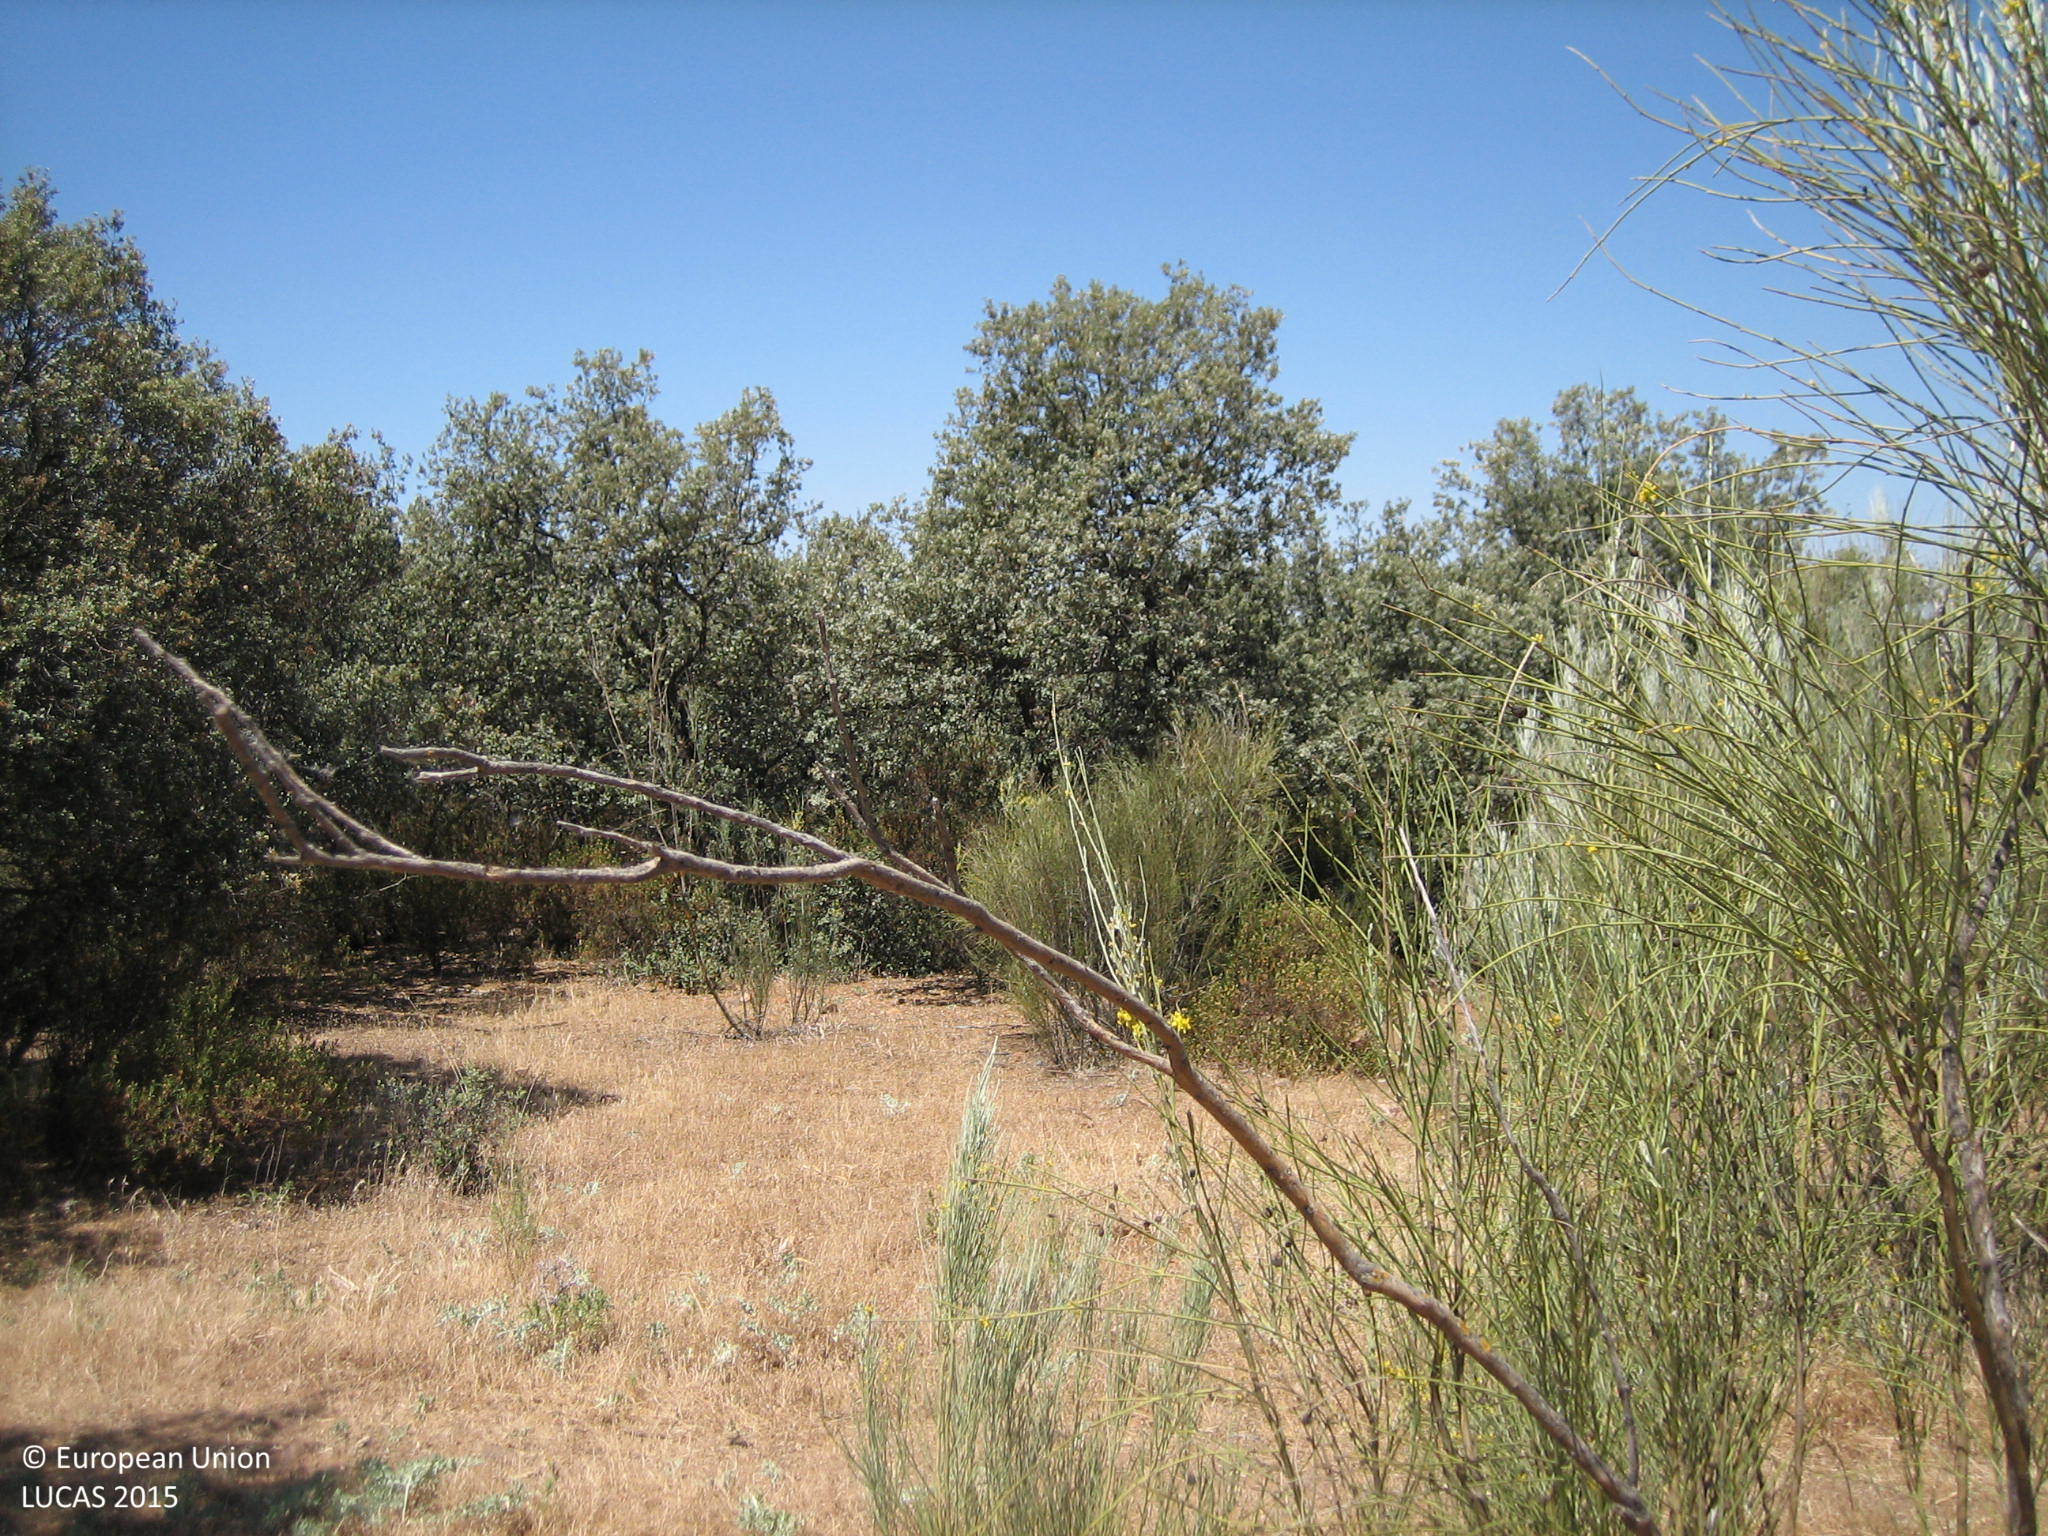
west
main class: Cropland
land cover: Oats
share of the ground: > 75 %
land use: Agriculture (excluding fallow land and kitchen gardens)
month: June
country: ES
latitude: 38.7916
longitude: -4.0535
